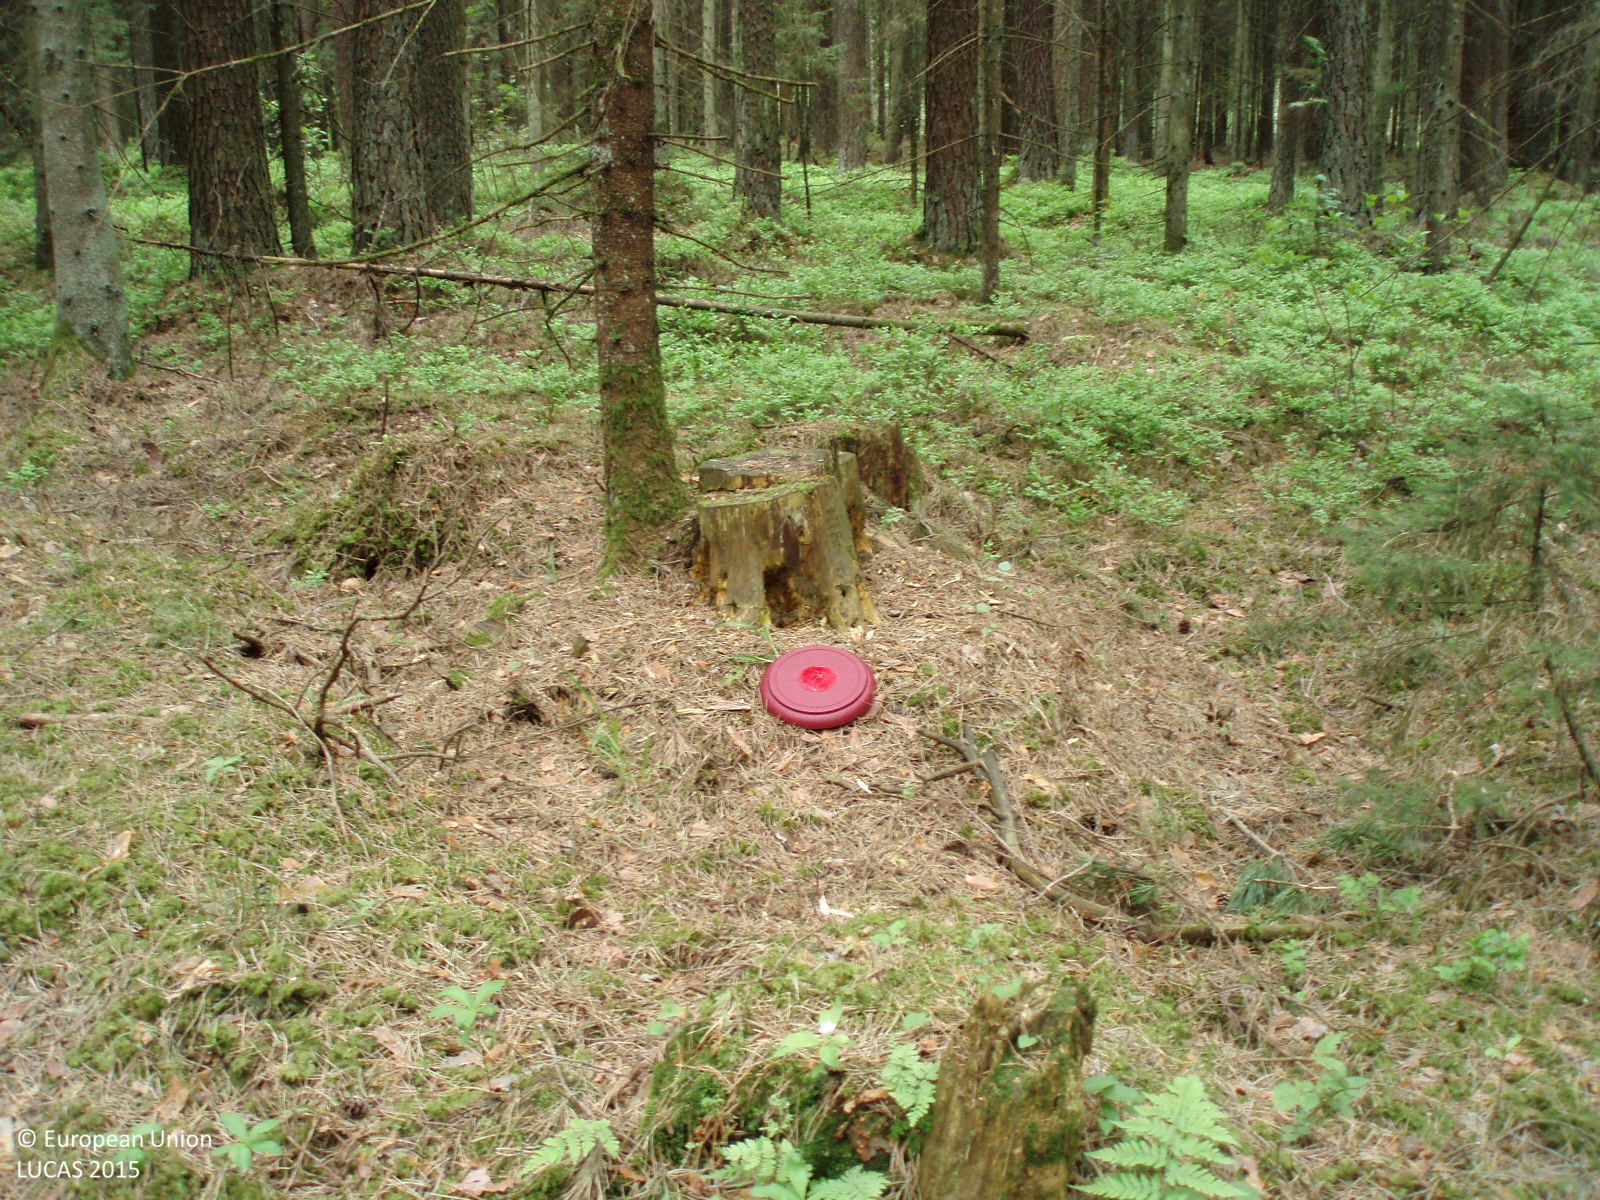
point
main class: Woodland
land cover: Pine dominated coniferous woodland
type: hemiboreal forest and nemoral coniferous forest and mixed broadleaved-coniferous forest
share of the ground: > 75 %
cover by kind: coniferous forest trees 95 %, herbaceous plants 5 %
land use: Forestry
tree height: > 5 m
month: May
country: LT
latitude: 56.2092
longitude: 22.5211
